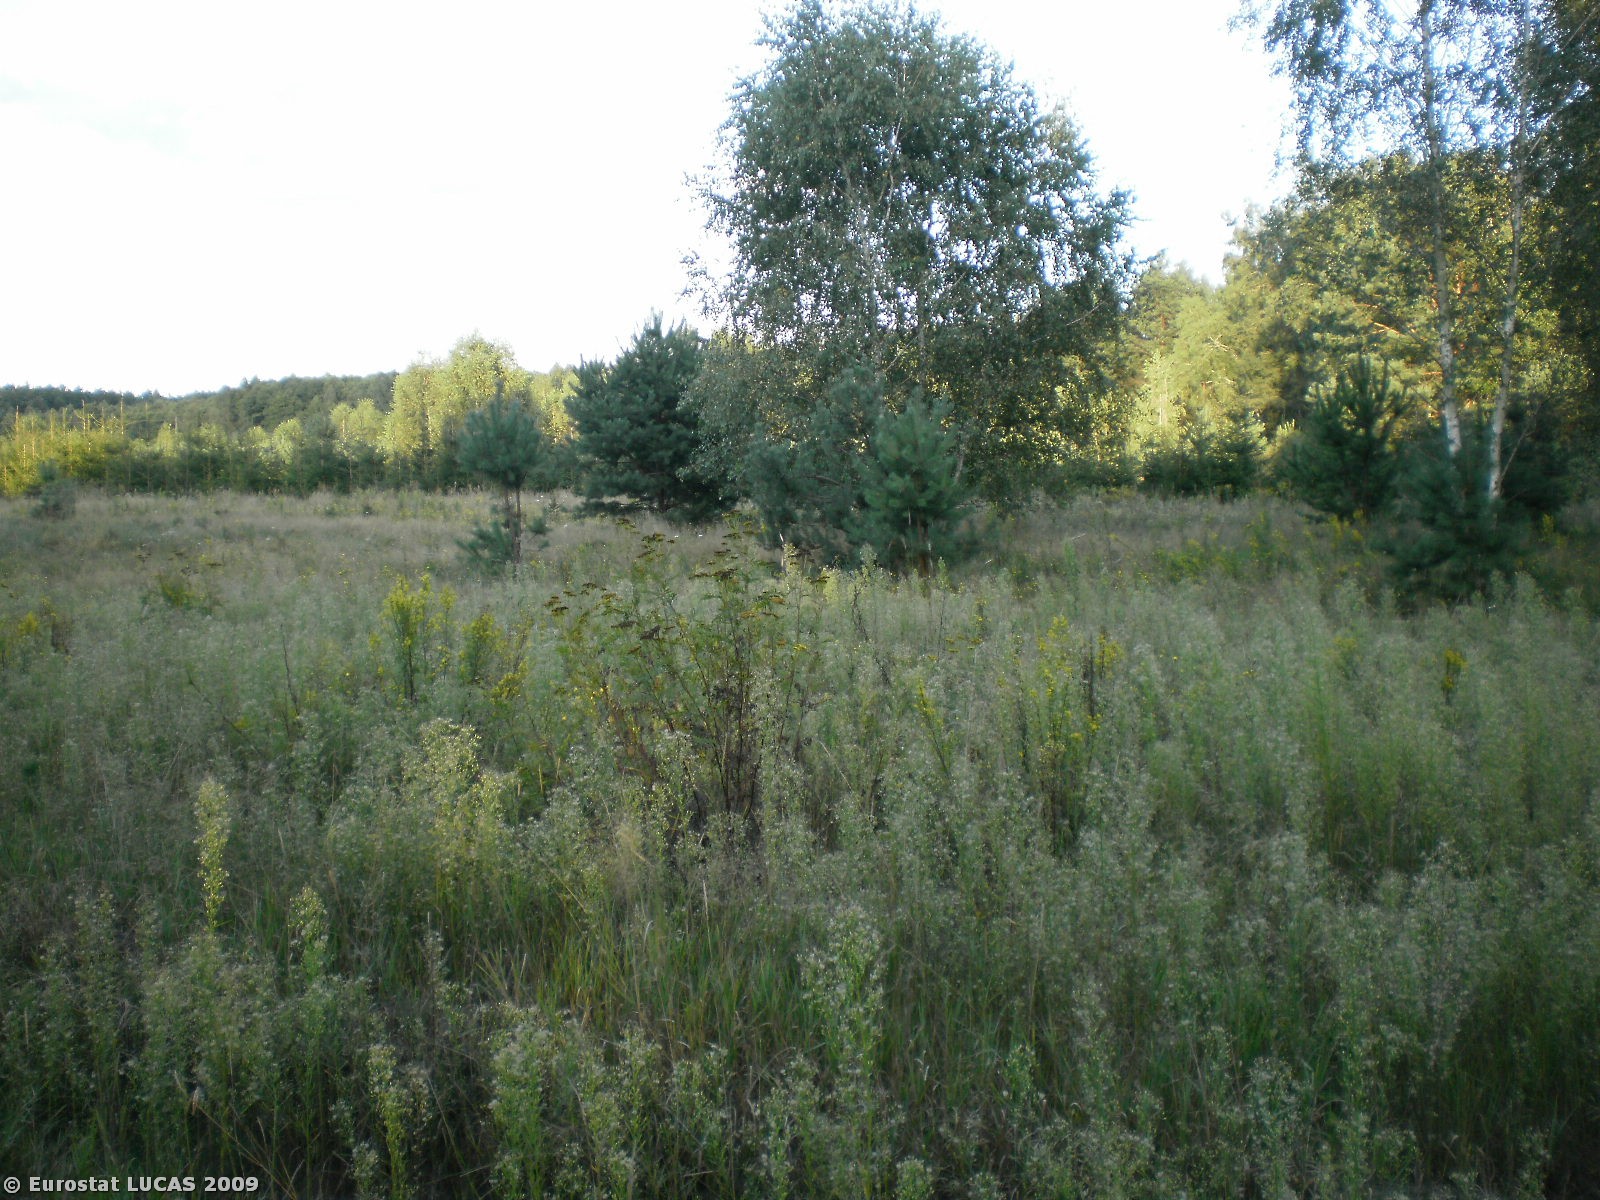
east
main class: Woodland
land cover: Coniferous woodland
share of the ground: > 75 %
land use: Forestry
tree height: < 5 m
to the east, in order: Coniferous woodland; Grassland without tree/shrub cover; Grassland with sparse tree/shrub cover; Mixed woodland; Grass margins; Tracks; Grassland with sparse tree/shrub cover; Mixed woodland; Broadleaved woodland; Grassland with sparse tree/shrub cover
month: August
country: PL
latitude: 52.5725
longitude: 21.7554
